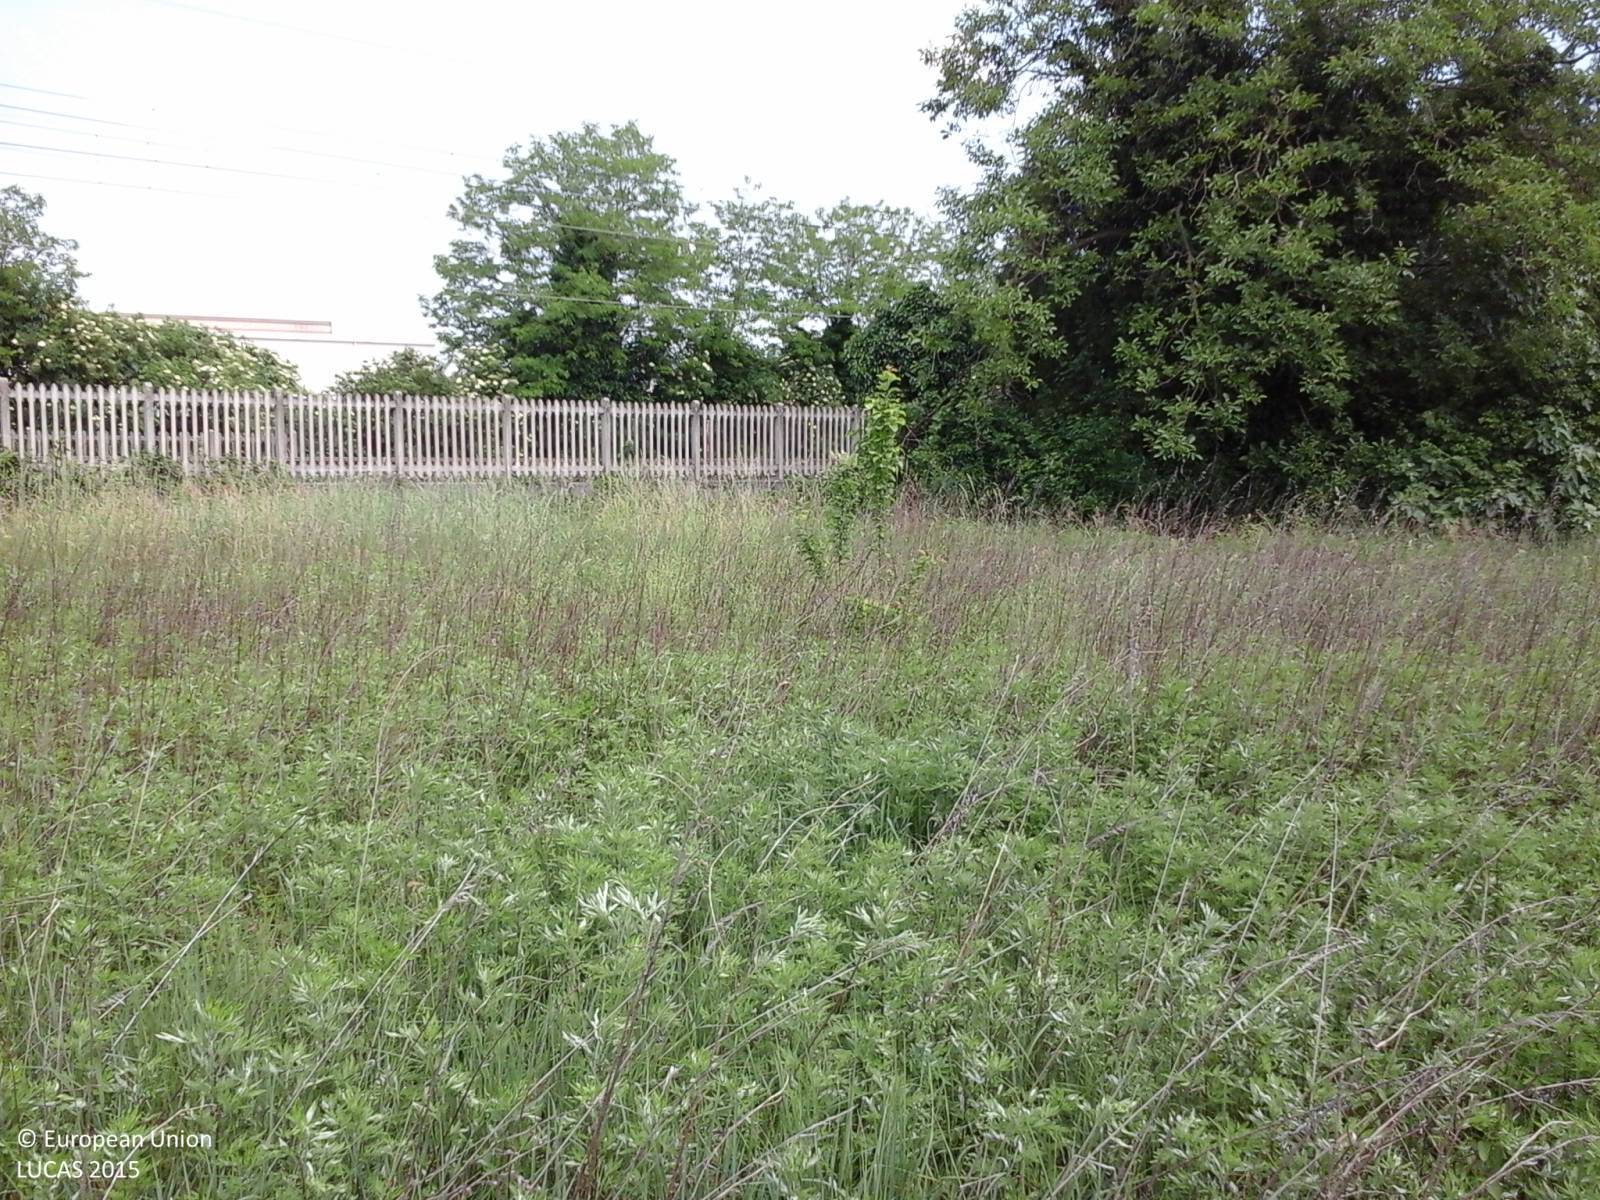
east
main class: Grassland
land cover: Spontaneously vegetated surfaces
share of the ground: > 75 %
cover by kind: herbaceous plants 100 %
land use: Fallow land
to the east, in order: Spontaneously vegetated surfaces; Broadleaved woodland; Grass margins; Artificial constructions in urban areas; Grass margins; Maize
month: May
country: IT
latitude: 46.0302
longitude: 13.2908
